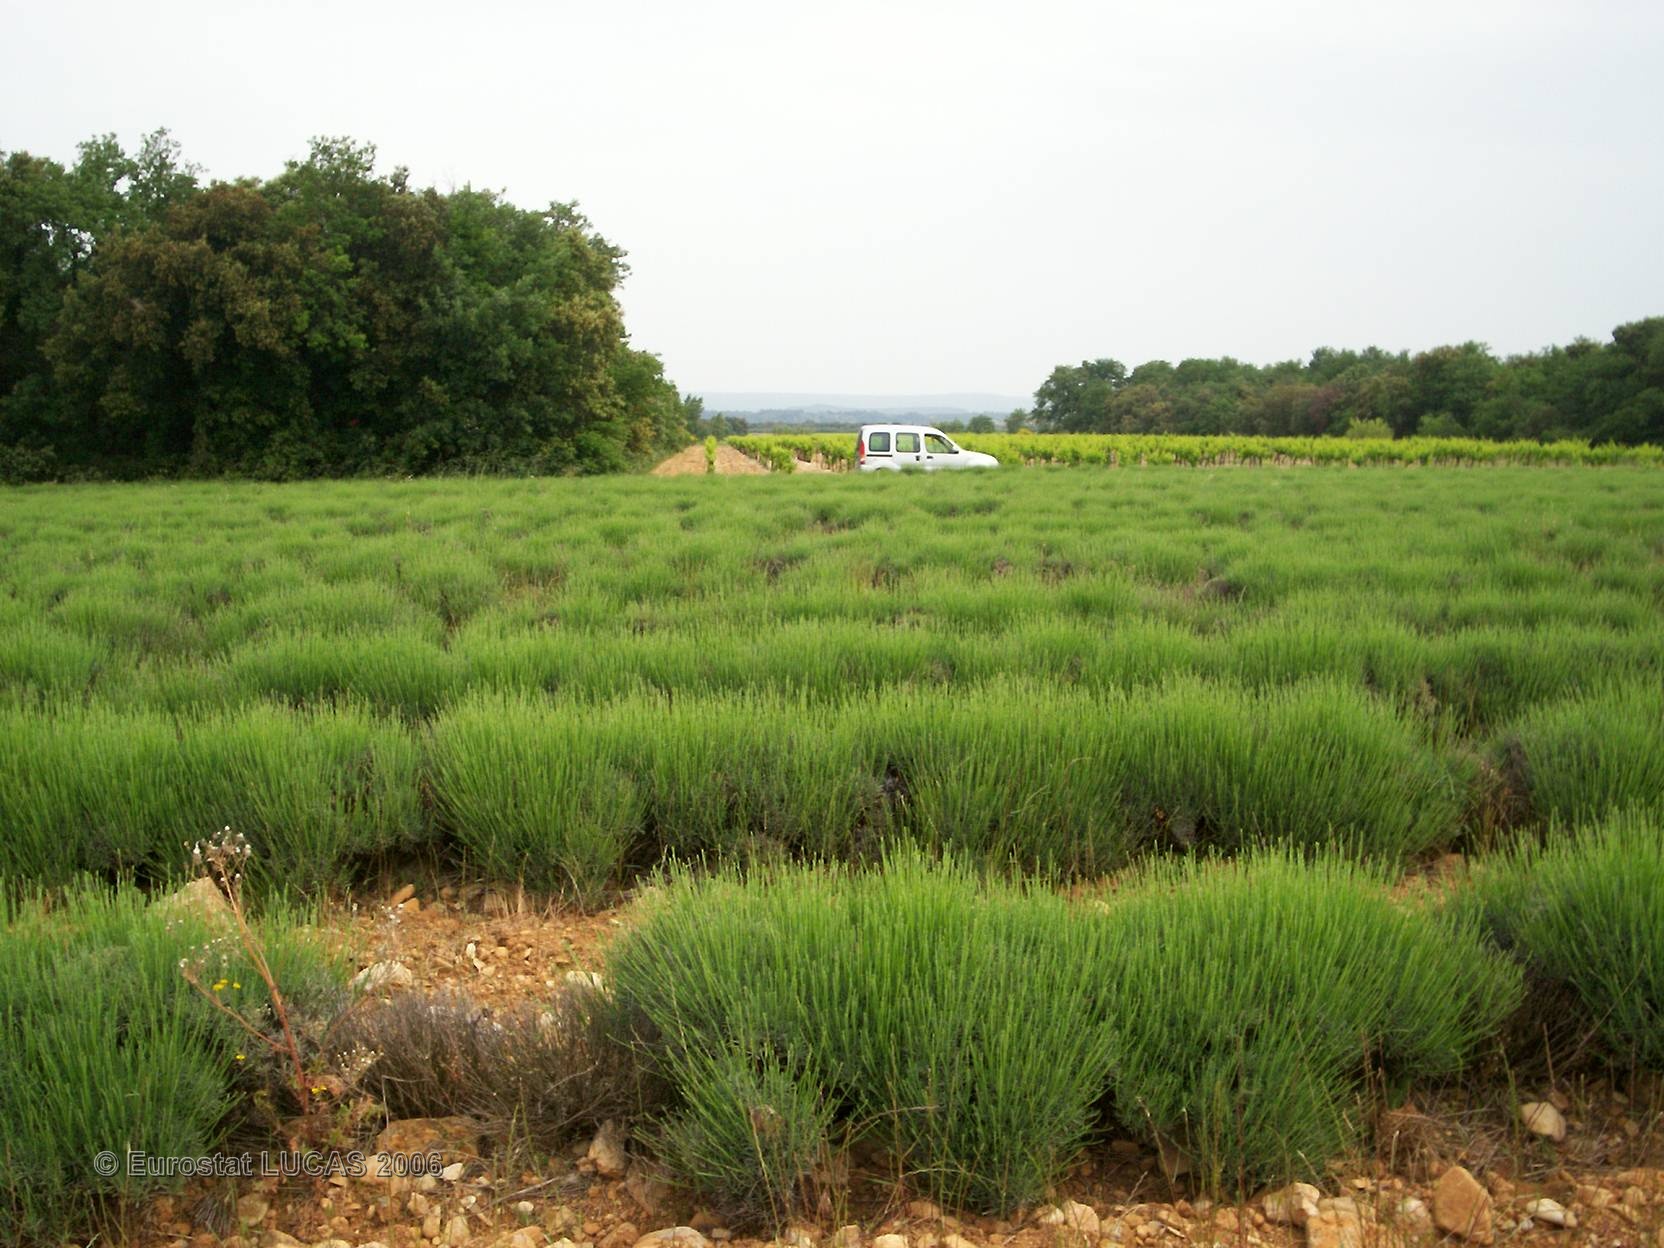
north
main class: Cropland
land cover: Permanent industrial crops
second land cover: Bare land
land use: Agriculture (excluding fallow land and kitchen gardens)
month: May
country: FR
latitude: 44.3709
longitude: 4.9248
